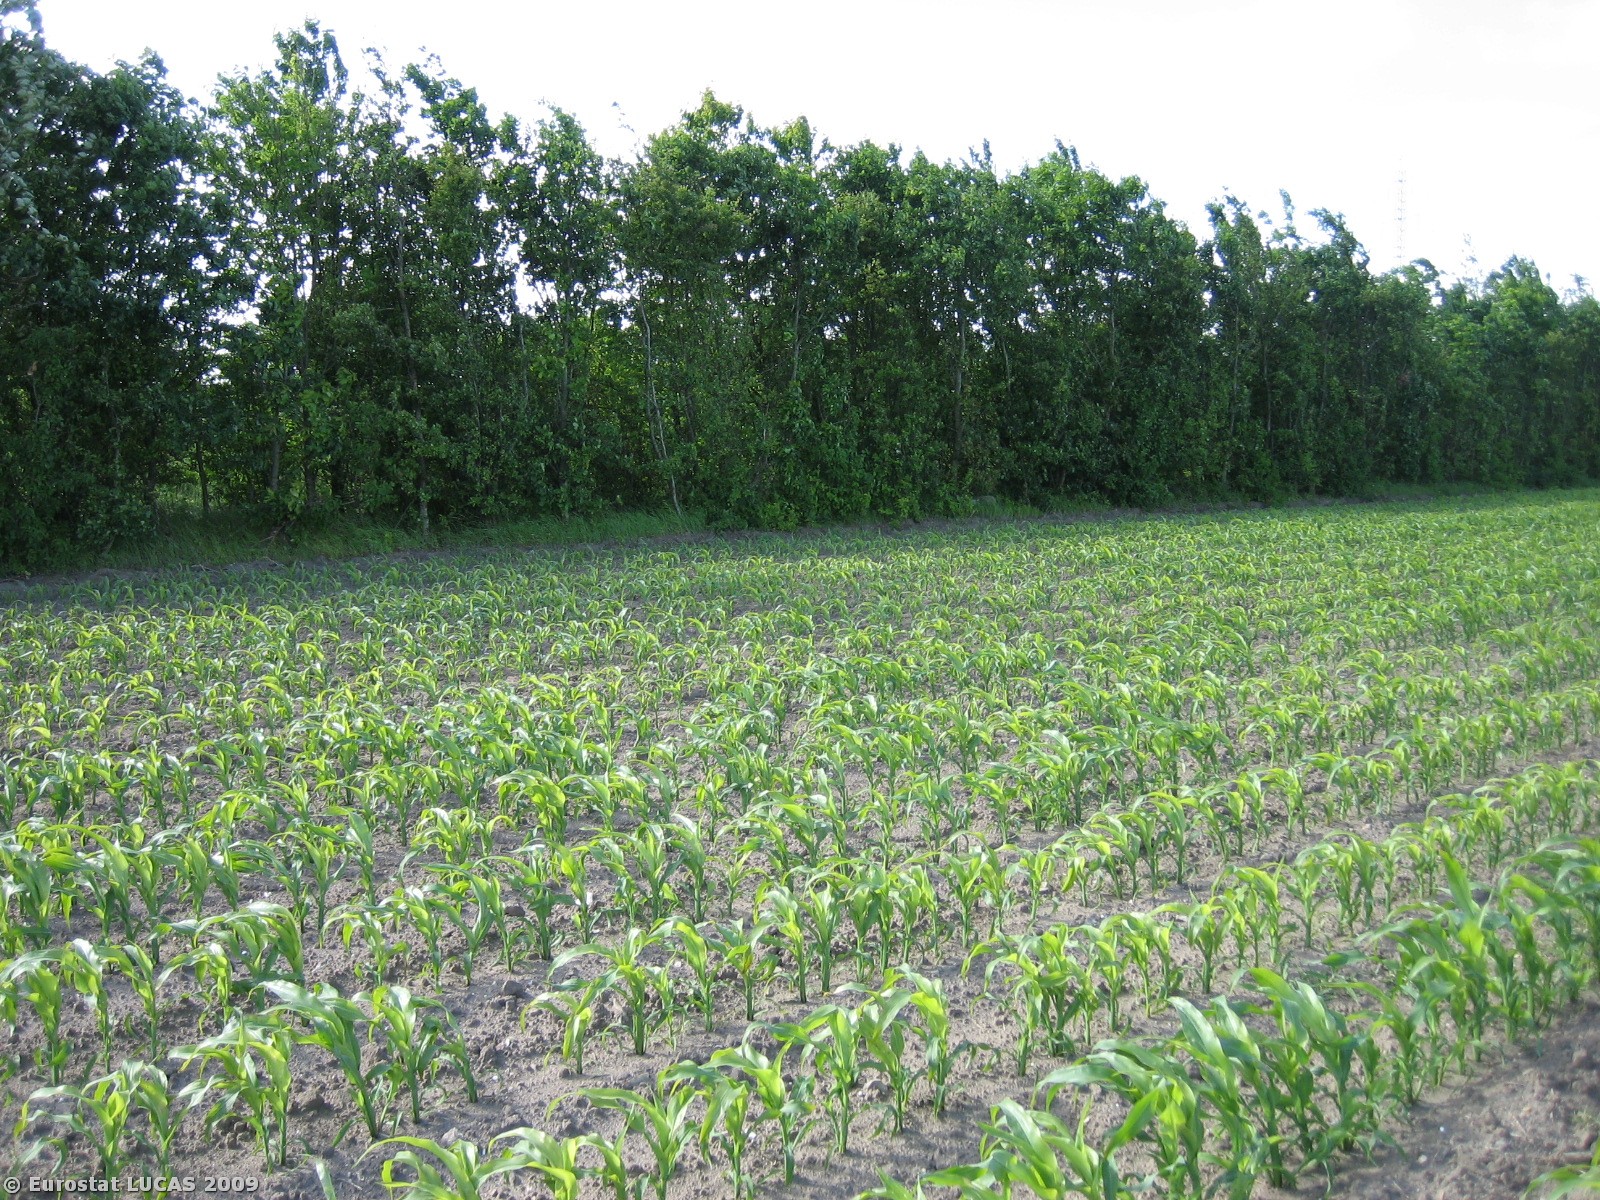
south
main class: Cropland
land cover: Maize
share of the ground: 10 - 25 %
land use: Agriculture (excluding fallow land and kitchen gardens)
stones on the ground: < 10 %
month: June
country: DK
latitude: 55.8640
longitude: 9.7606
